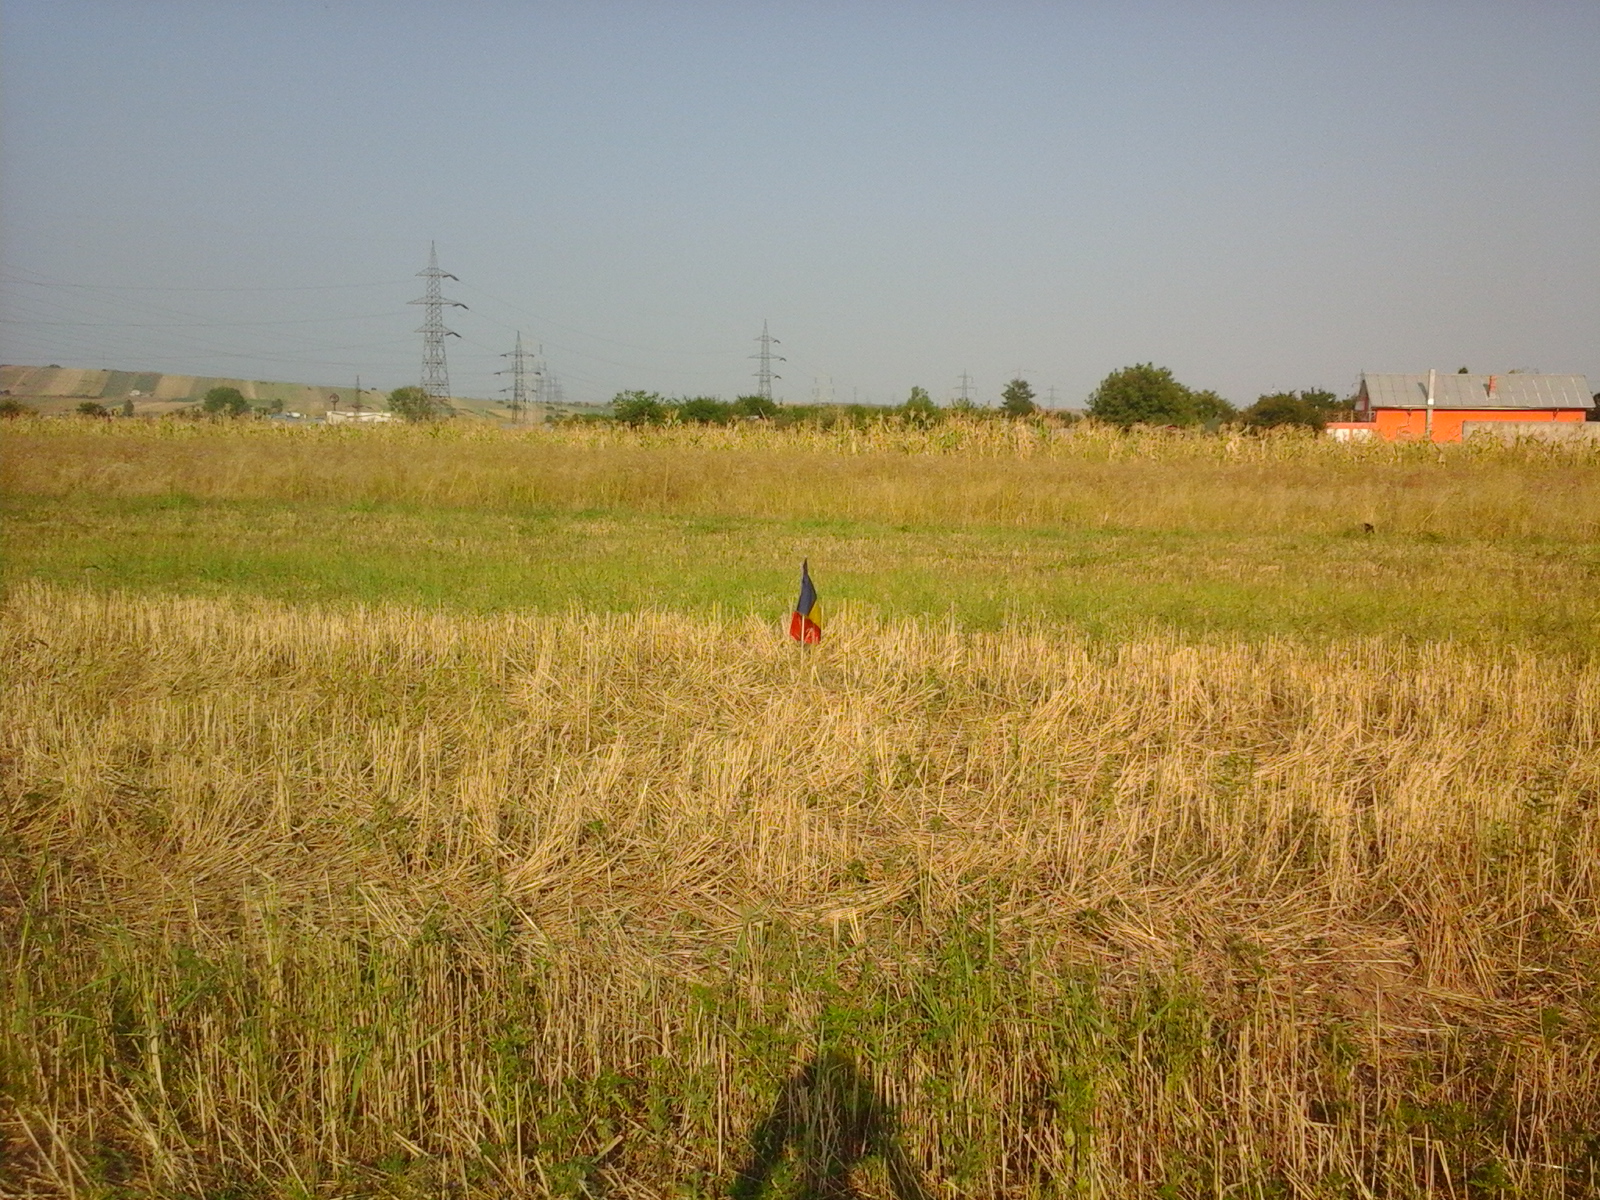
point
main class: Cropland
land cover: Common wheat
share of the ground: > 75 %
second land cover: Spontaneously vegetated surfaces
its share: 25 - 50 %
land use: Agriculture (excluding fallow land and kitchen gardens)
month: August
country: RO
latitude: 44.3771
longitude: 23.7747
